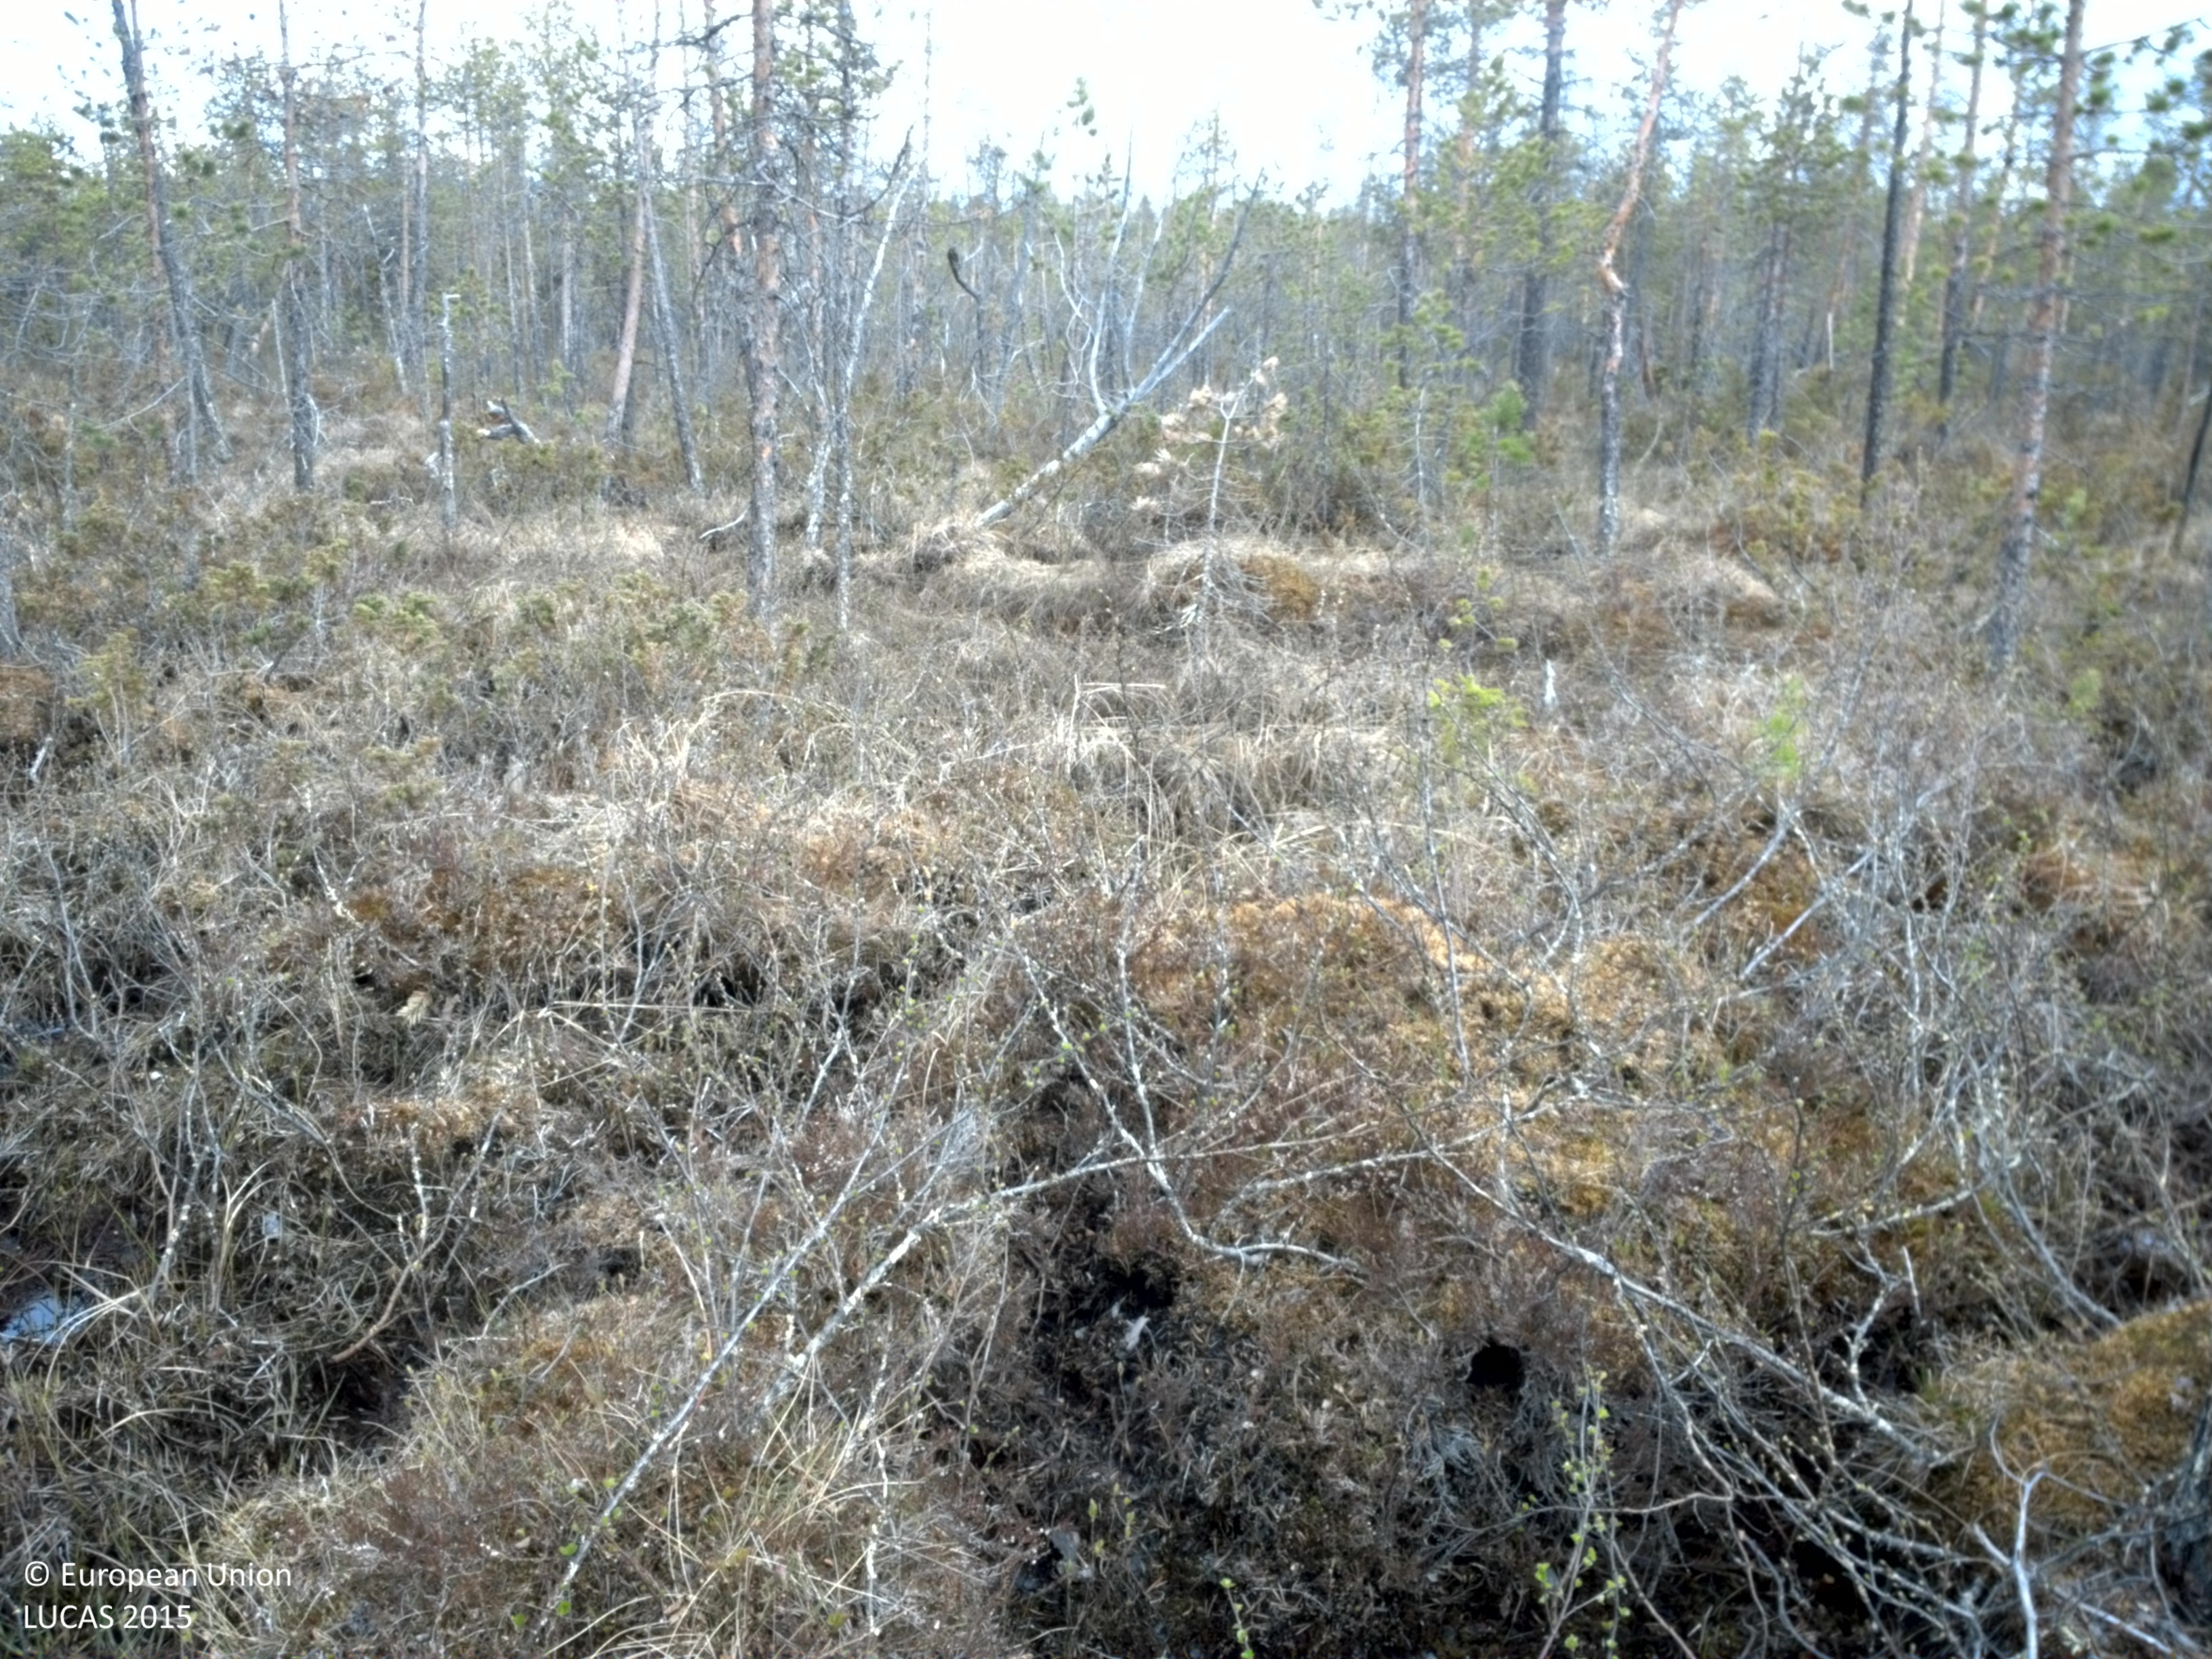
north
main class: Woodland
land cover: Pine dominated coniferous woodland
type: boreal forest
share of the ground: 25 - 50 %
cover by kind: shrubs 35 %, herbaceous plants 35 %, coniferous forest trees 25 %, lichens and mosses 5 %
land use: Forestry
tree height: > 5 m
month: June
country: SE
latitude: 66.9954
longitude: 21.3054
